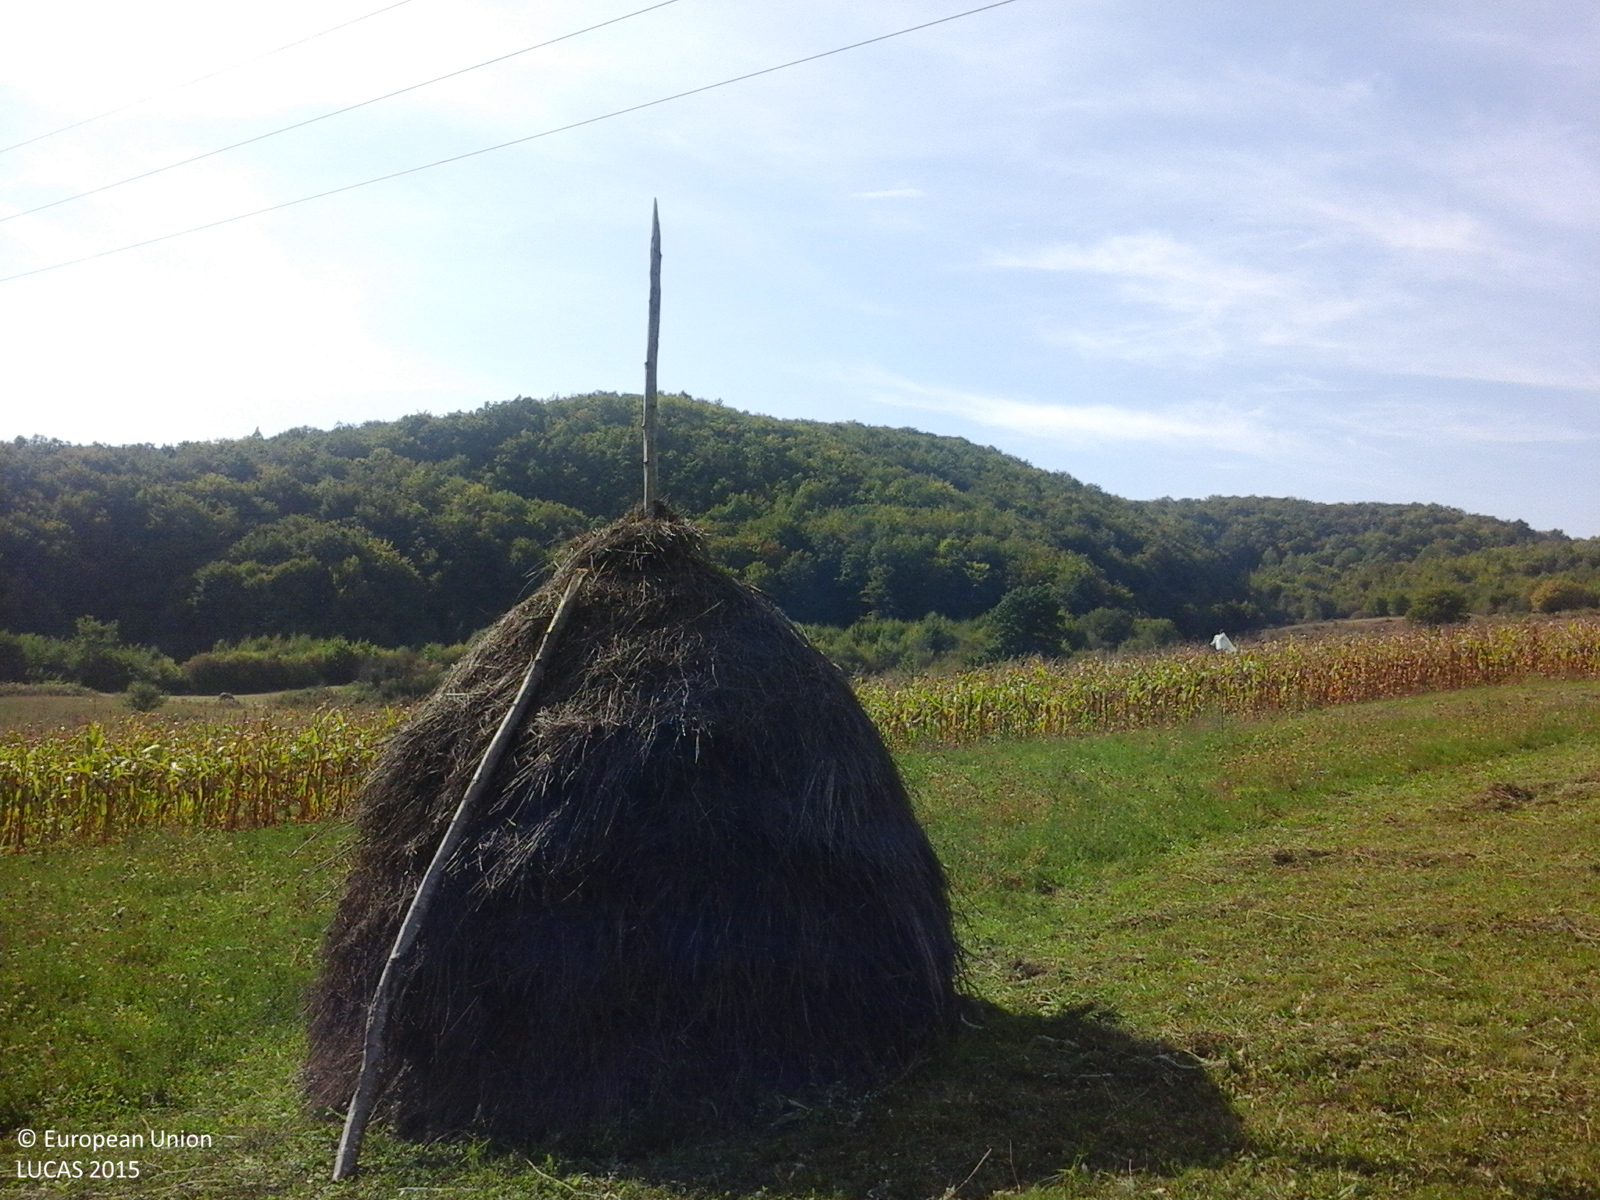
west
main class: Grassland
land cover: Grassland without tree/shrub cover
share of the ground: > 75 %
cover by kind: herbaceous plants 100 %
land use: Agriculture (excluding fallow land and kitchen gardens)
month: September
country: RO
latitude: 47.3177
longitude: 23.7704
